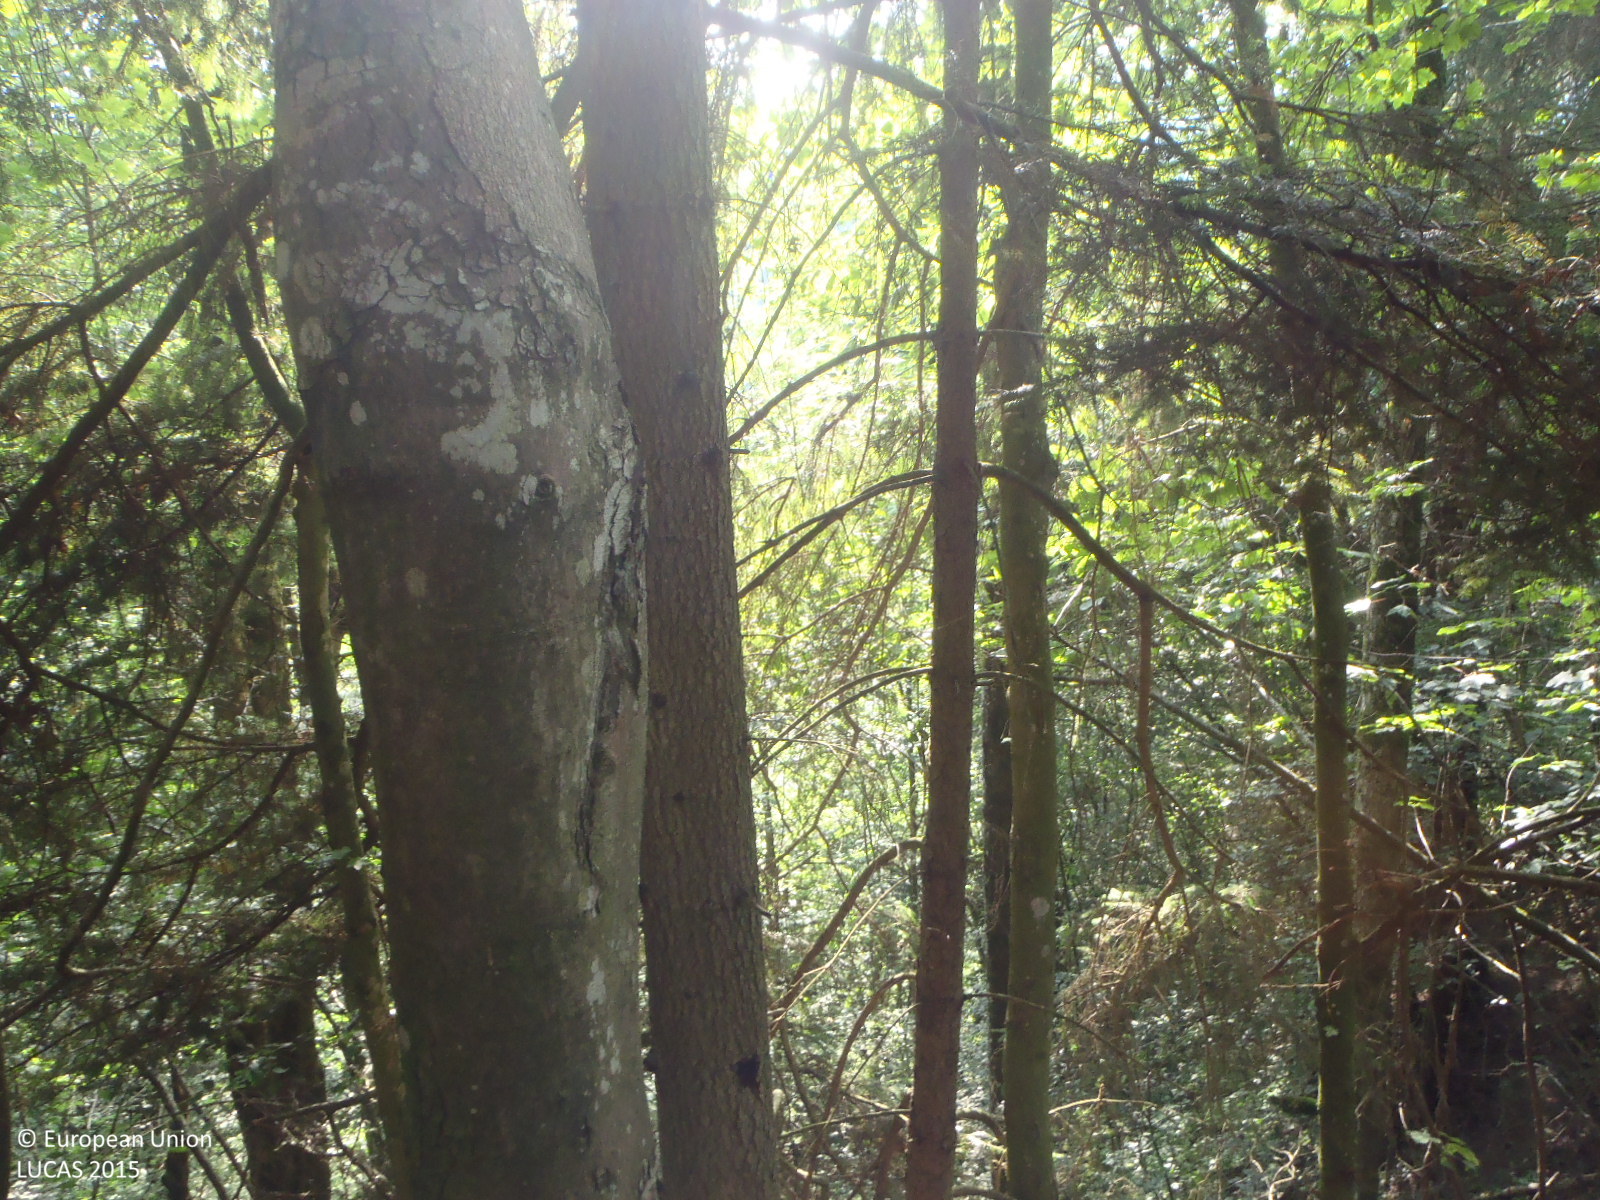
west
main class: Woodland
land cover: Spruce dominated mixed woodland
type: alpine coniferous forest
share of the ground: > 75 %
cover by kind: coniferous forest trees 70 %, broadleaved forest trees 30 %
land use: Forestry
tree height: > 5 m
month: July
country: AT
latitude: 47.4151
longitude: 11.8938
